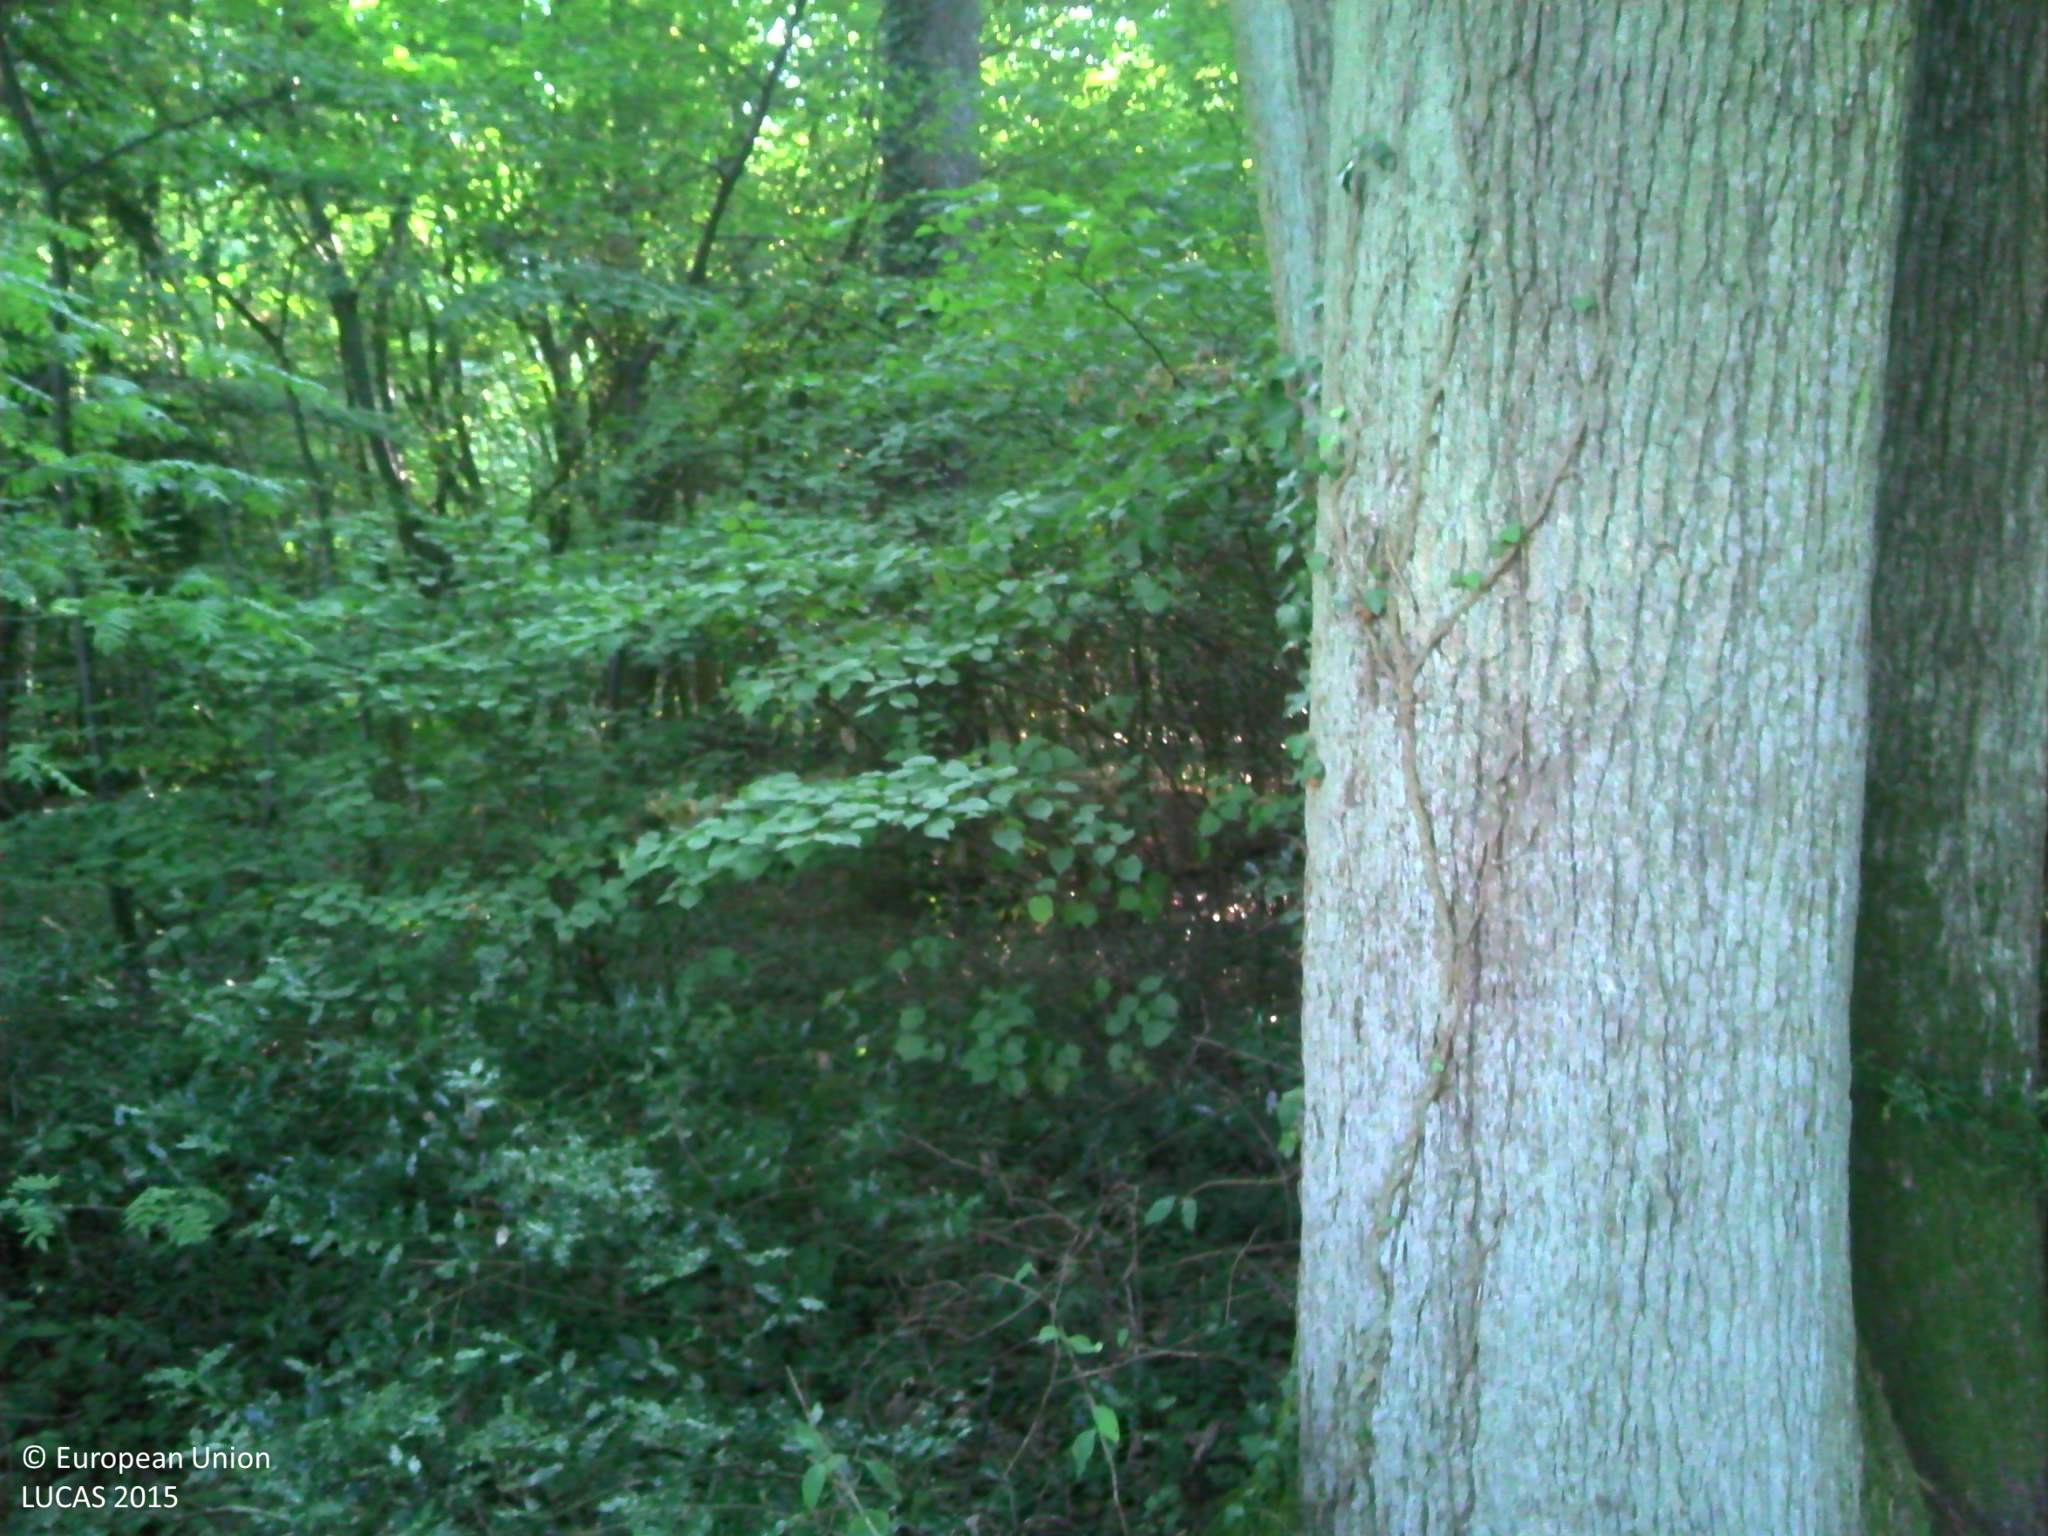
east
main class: Woodland
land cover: Spruce dominated mixed woodland
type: mesophytic deciduous forest
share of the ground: > 75 %
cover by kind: coniferous forest trees 50 %, herbaceous plants 30 %, broadleaved forest trees 20 %
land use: Forestry
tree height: > 5 m
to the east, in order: Spruce dominated mixed woodland; Tracks; Spruce dominated mixed woodland
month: August
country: FR
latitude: 46.4071
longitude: 4.8379
